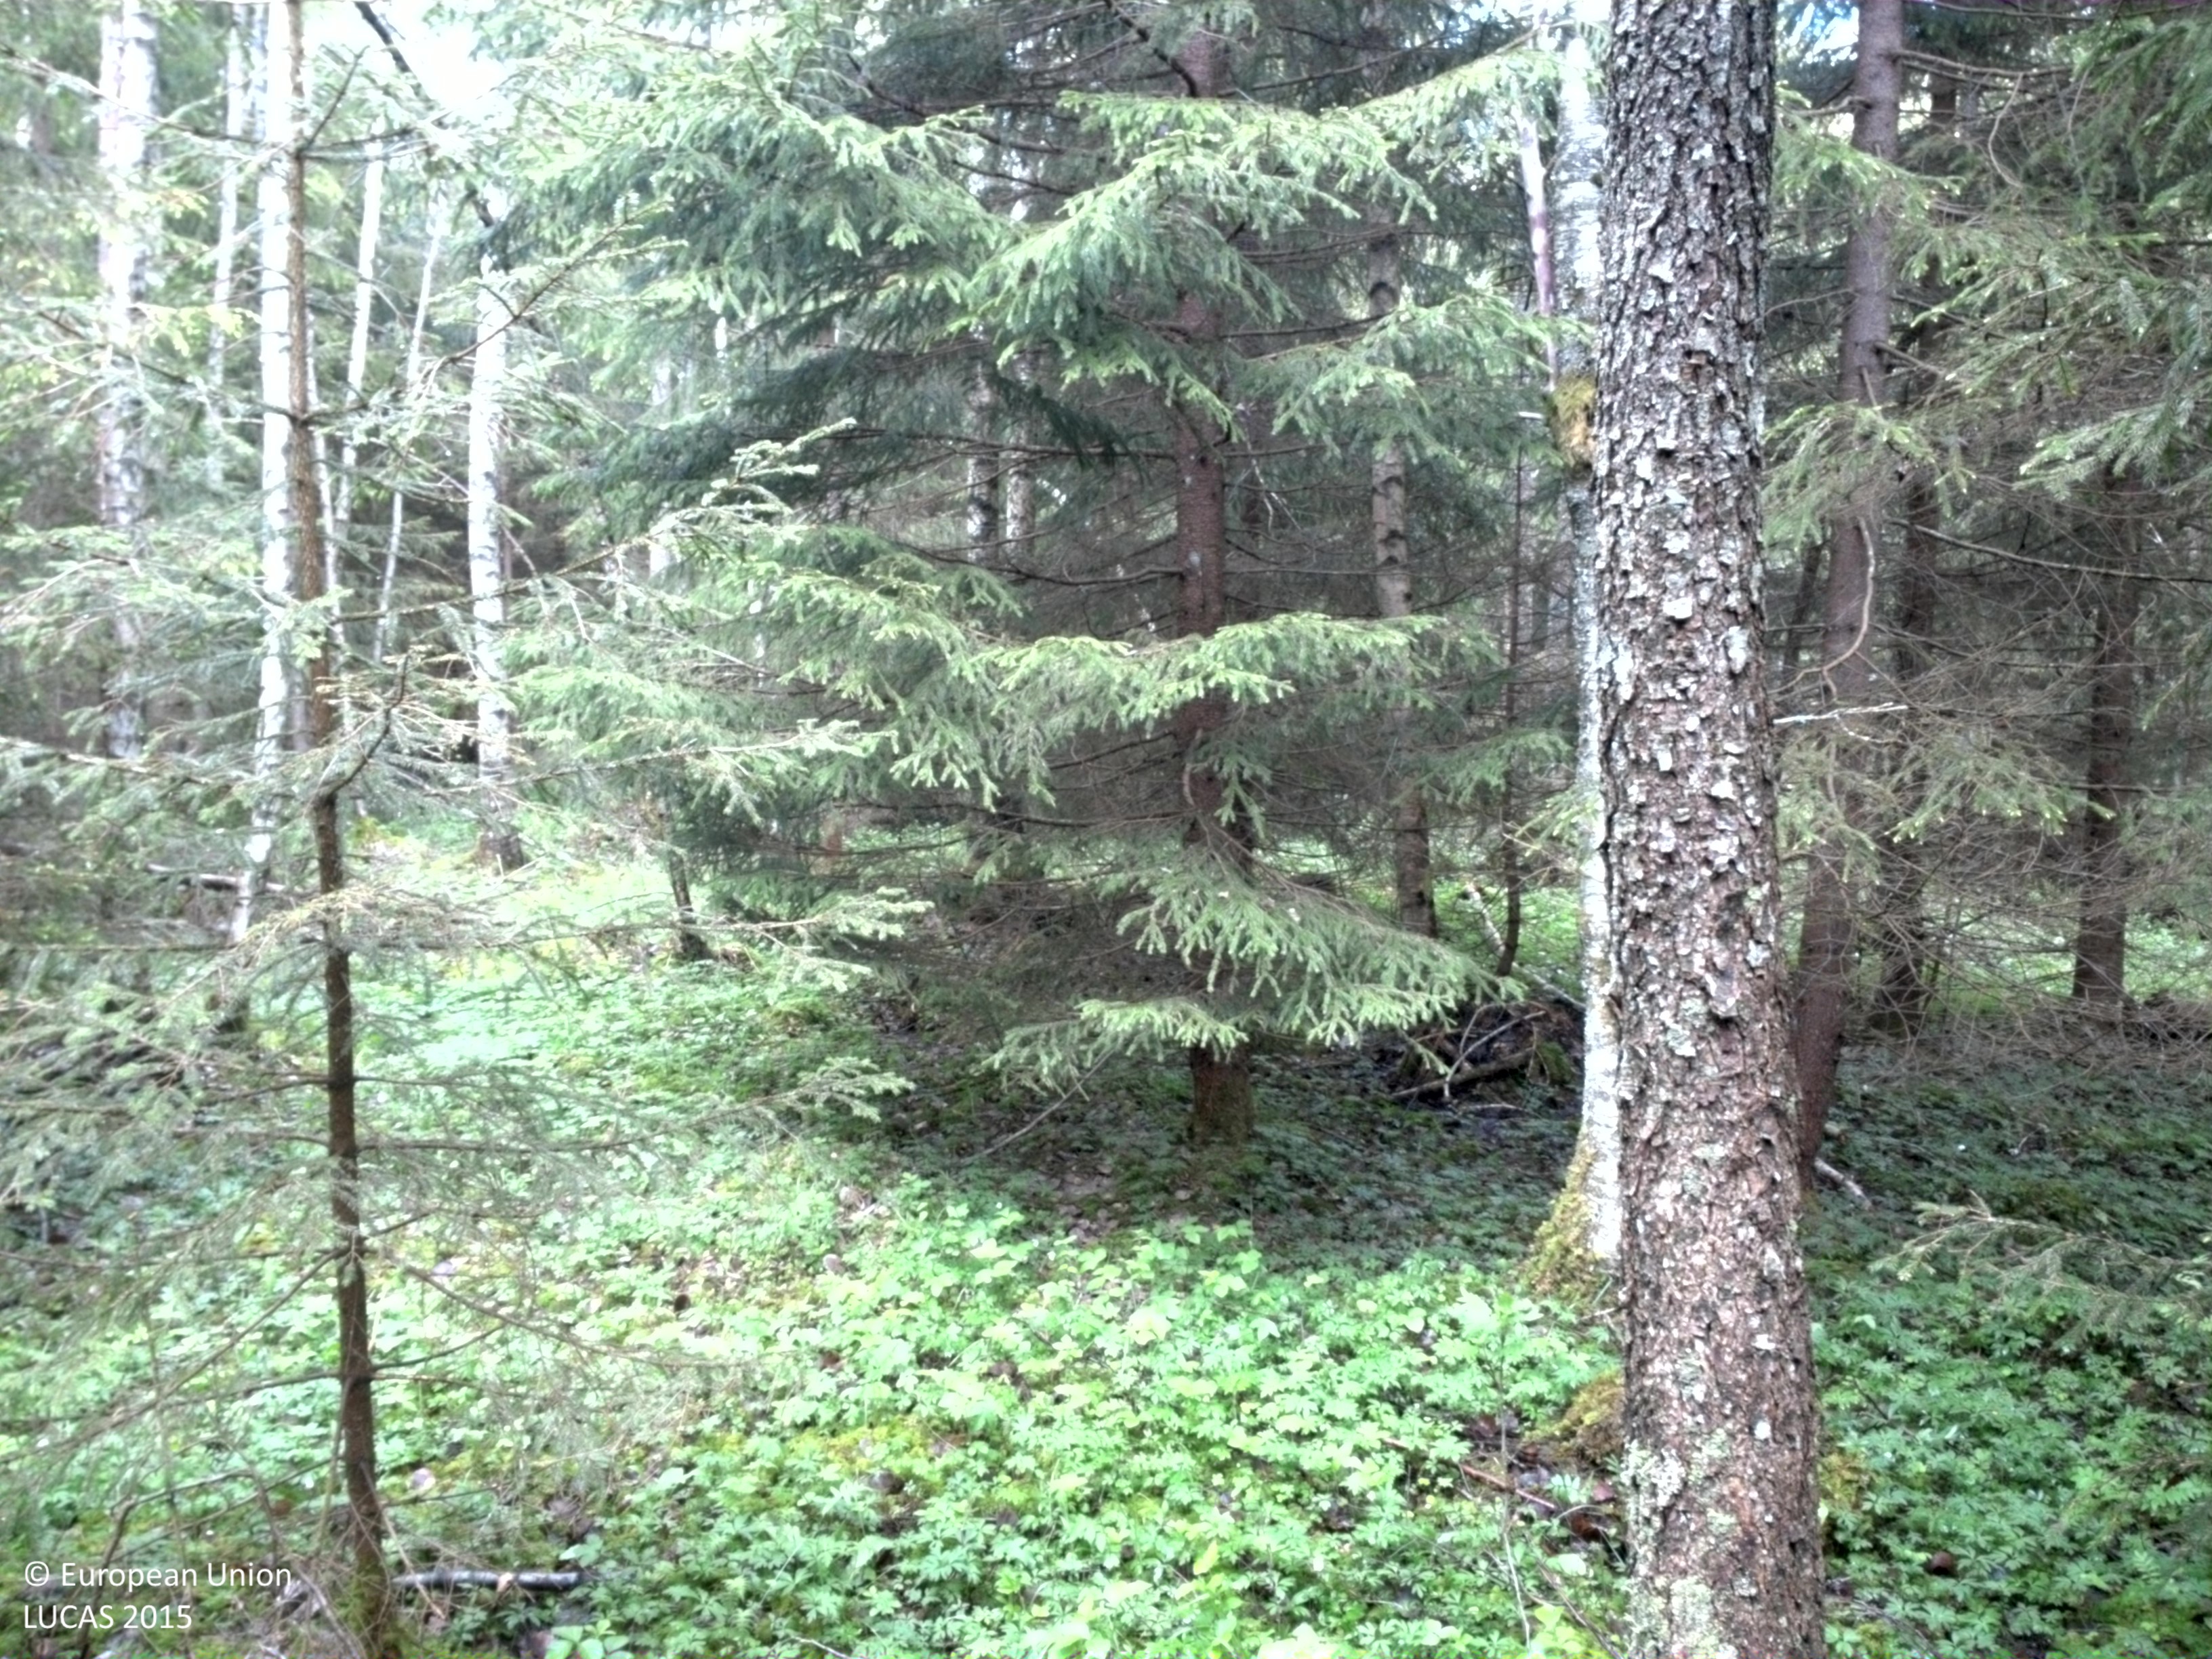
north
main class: Woodland
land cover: Spruce dominated coniferous woodland
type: boreal forest
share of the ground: > 75 %
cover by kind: coniferous forest trees 75 %, broadleaved forest trees 15 %, herbaceous plants 10 %
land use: Forestry
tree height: > 5 m
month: May
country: SE
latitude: 58.7392
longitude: 12.3274
